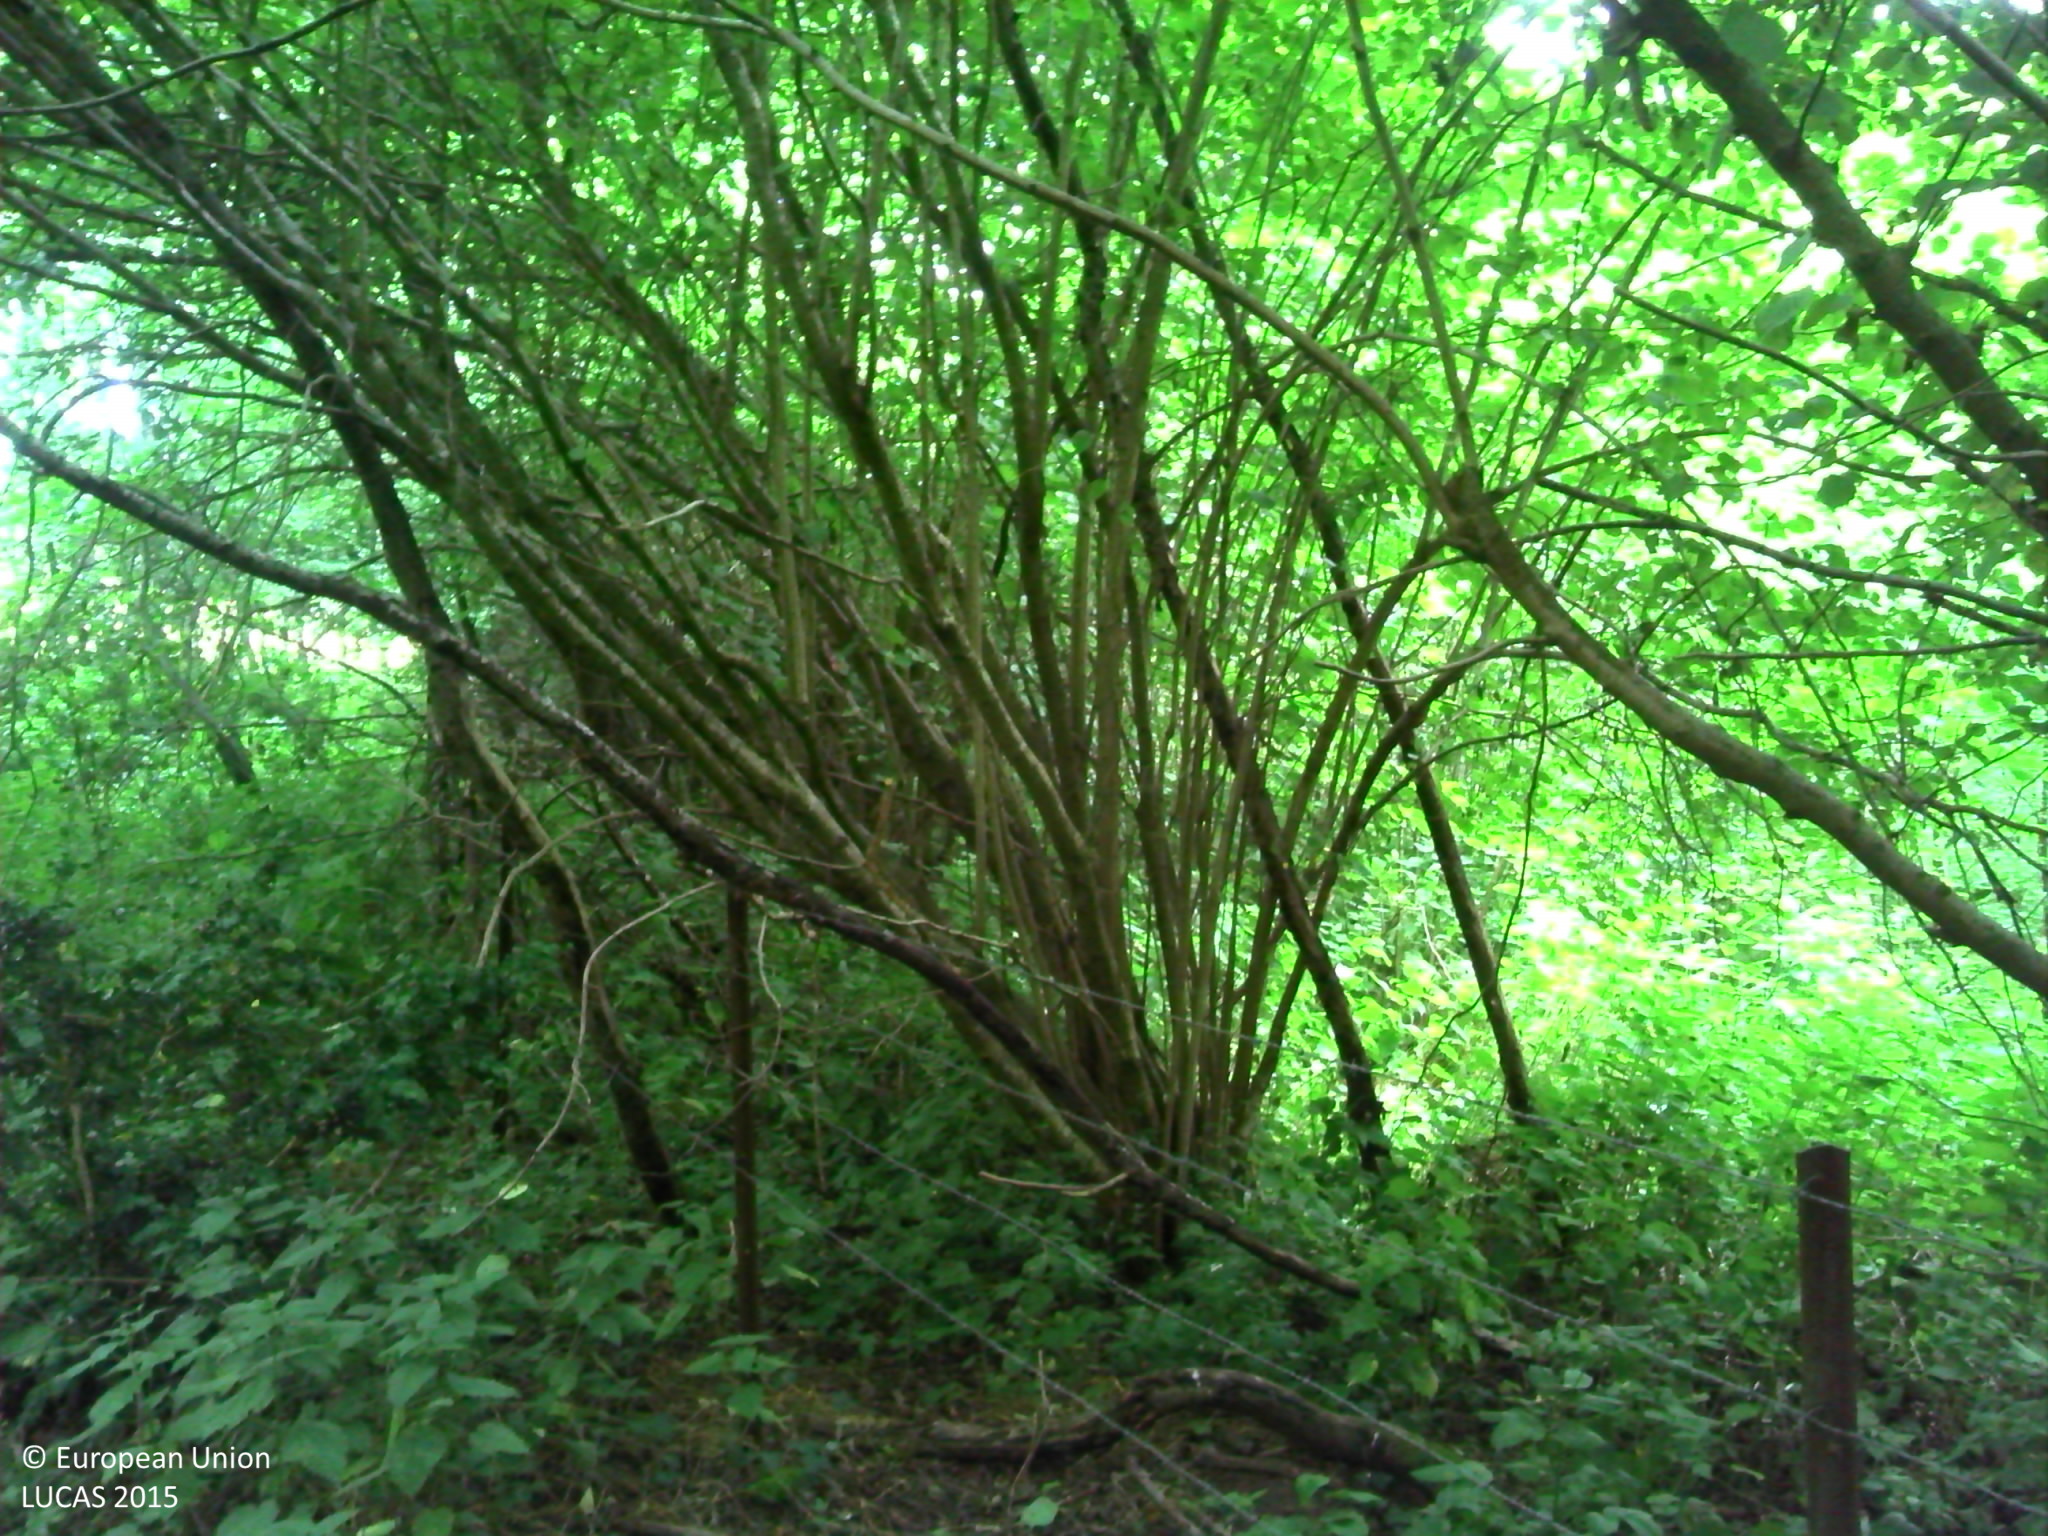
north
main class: Woodland
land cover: Broadleaved woodland
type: mesophytic deciduous forest
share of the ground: > 75 %
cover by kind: broadleaved forest trees 75 %, shrubs 15 %, herbaceous plants 10 %
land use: Forestry
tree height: > 5 m
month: July
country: FR
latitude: 49.4450
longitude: 1.9159
